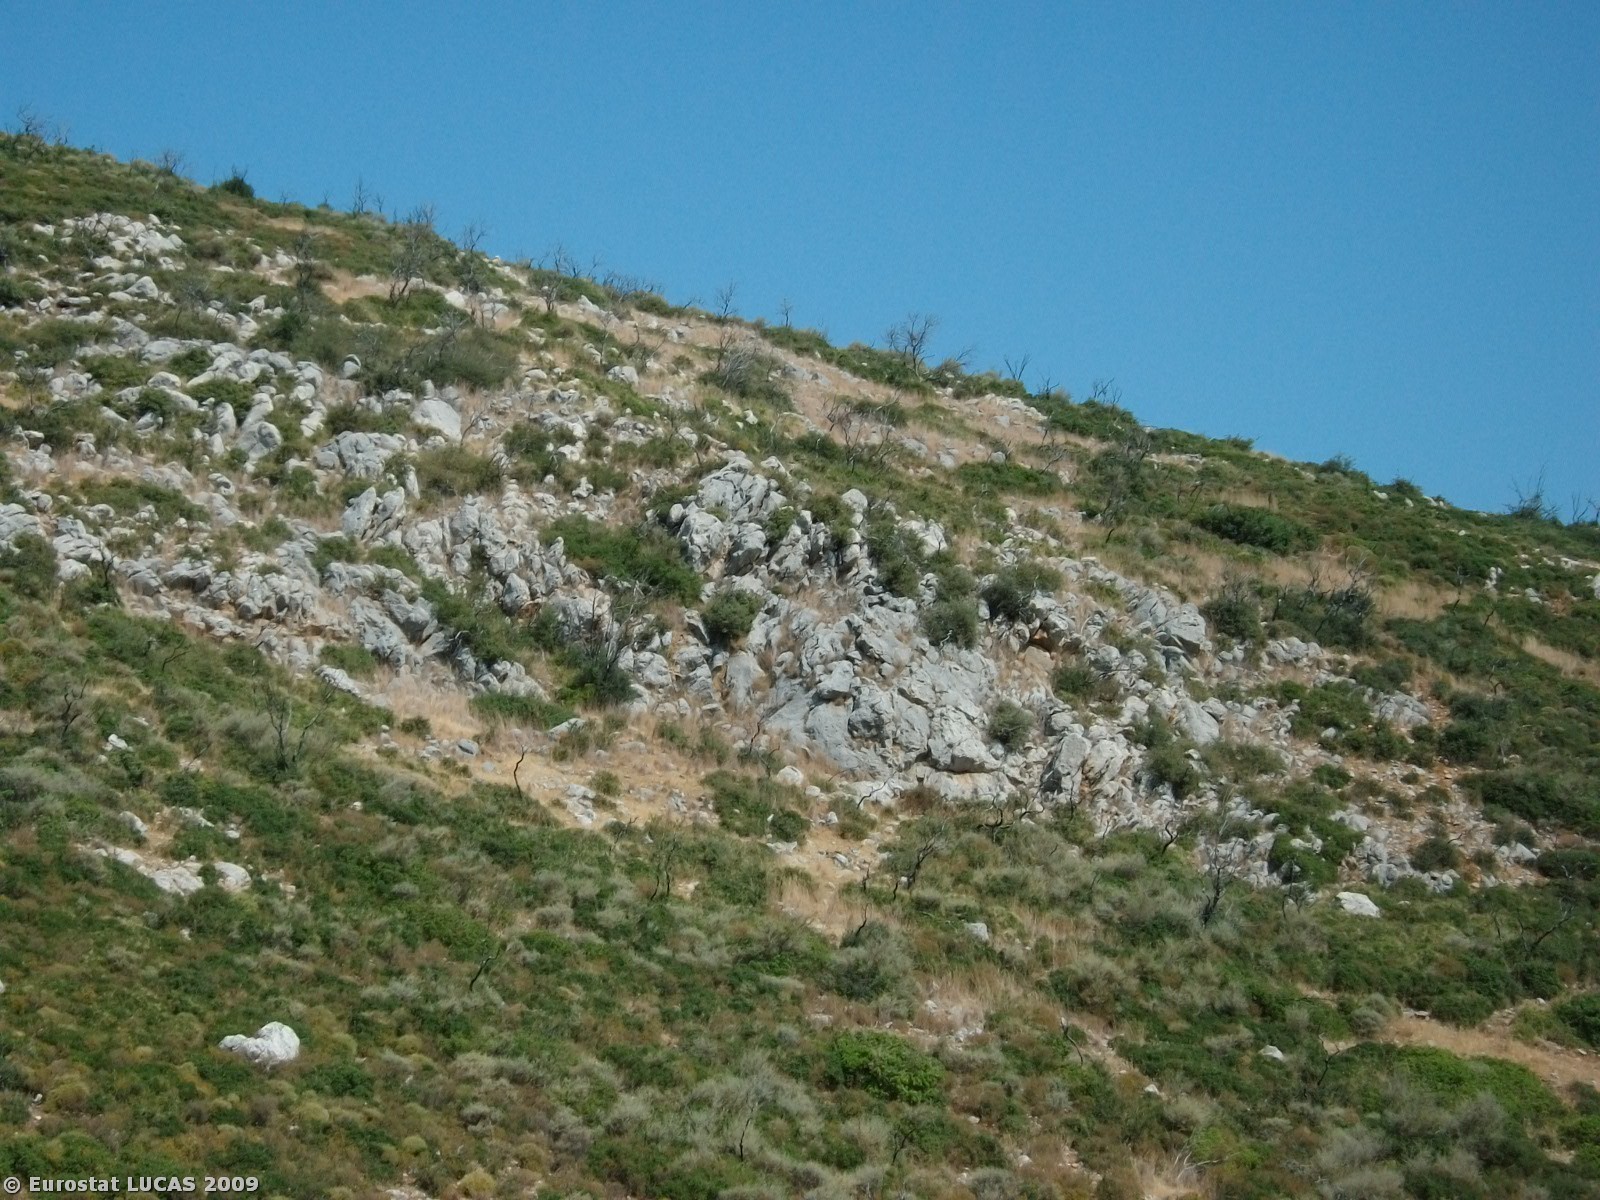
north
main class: Shrubland
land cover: Shrubland without tree cover
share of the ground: > 75 %
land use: Unused
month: August
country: GR
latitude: 38.6143
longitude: 23.1100
